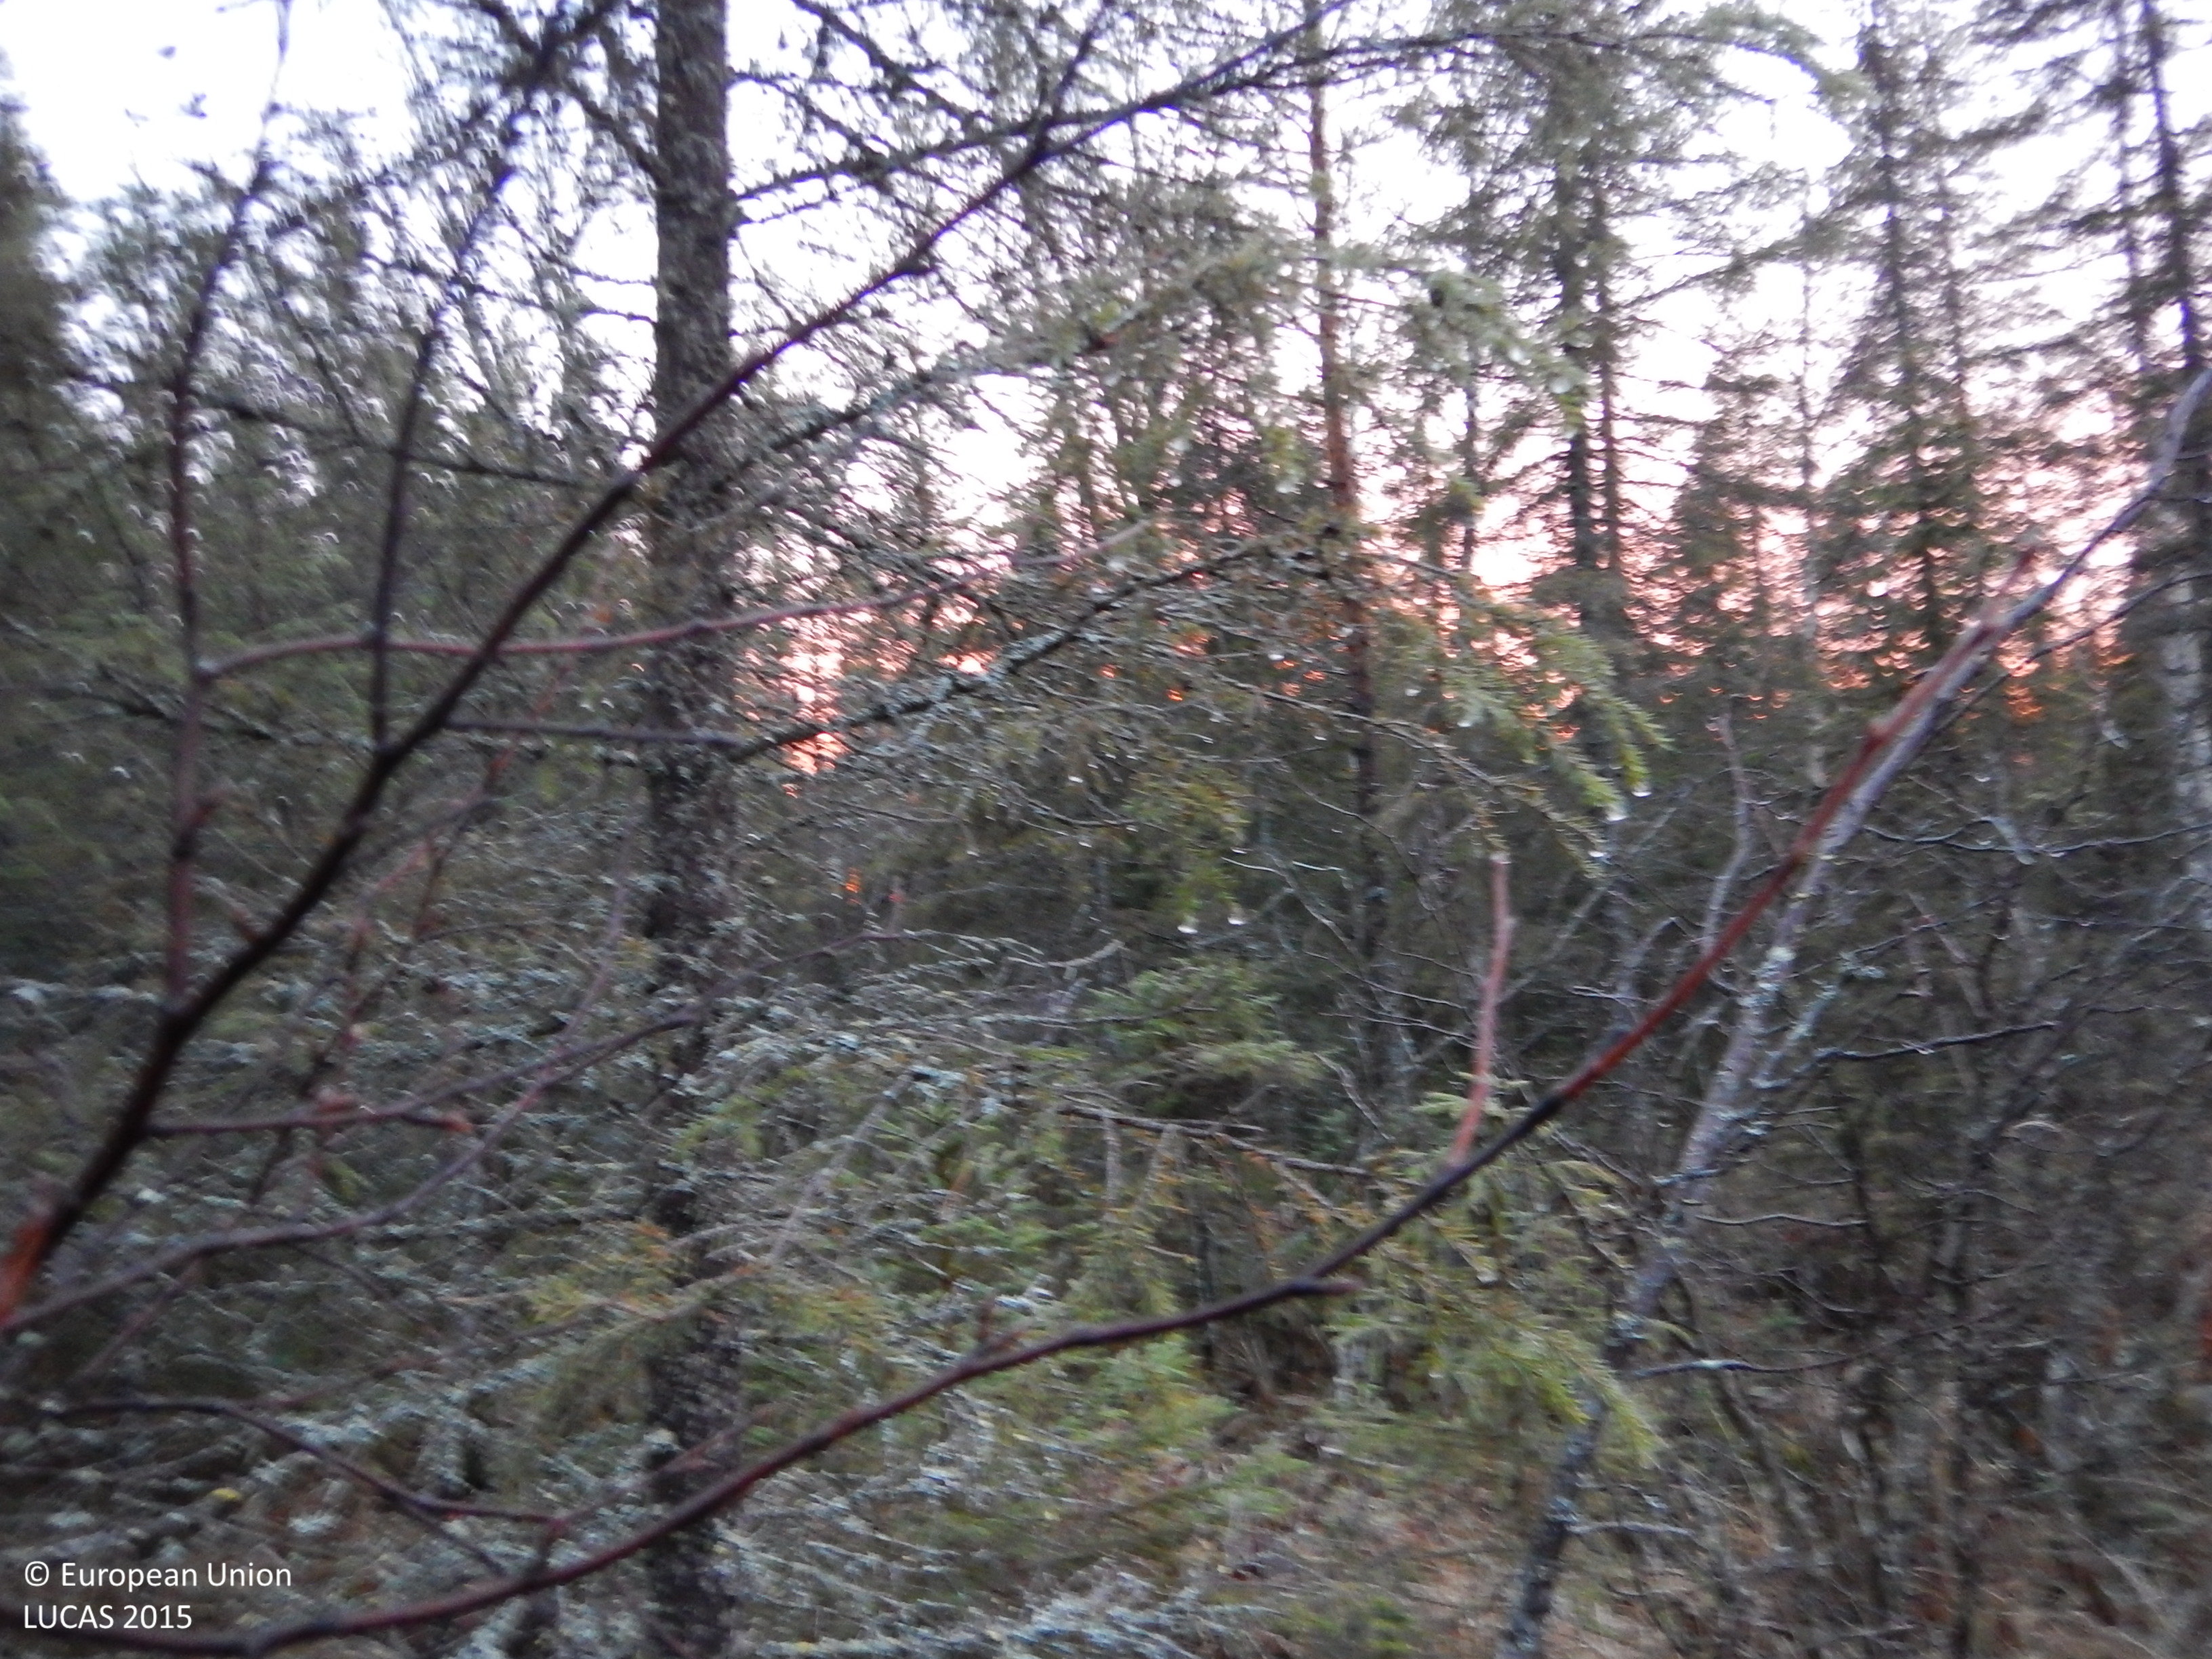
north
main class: Woodland
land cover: Broadleaved woodland
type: mire and swamp forests
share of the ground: 25 - 50 %
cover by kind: broadleaved forest trees 35 %, shrubs 20 %, herbaceous plants 20 %, lichens and mosses 20 %, coniferous forest trees 5 %
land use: Forestry
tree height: > 5 m
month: November
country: SE
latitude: 65.1457
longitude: 20.4828
